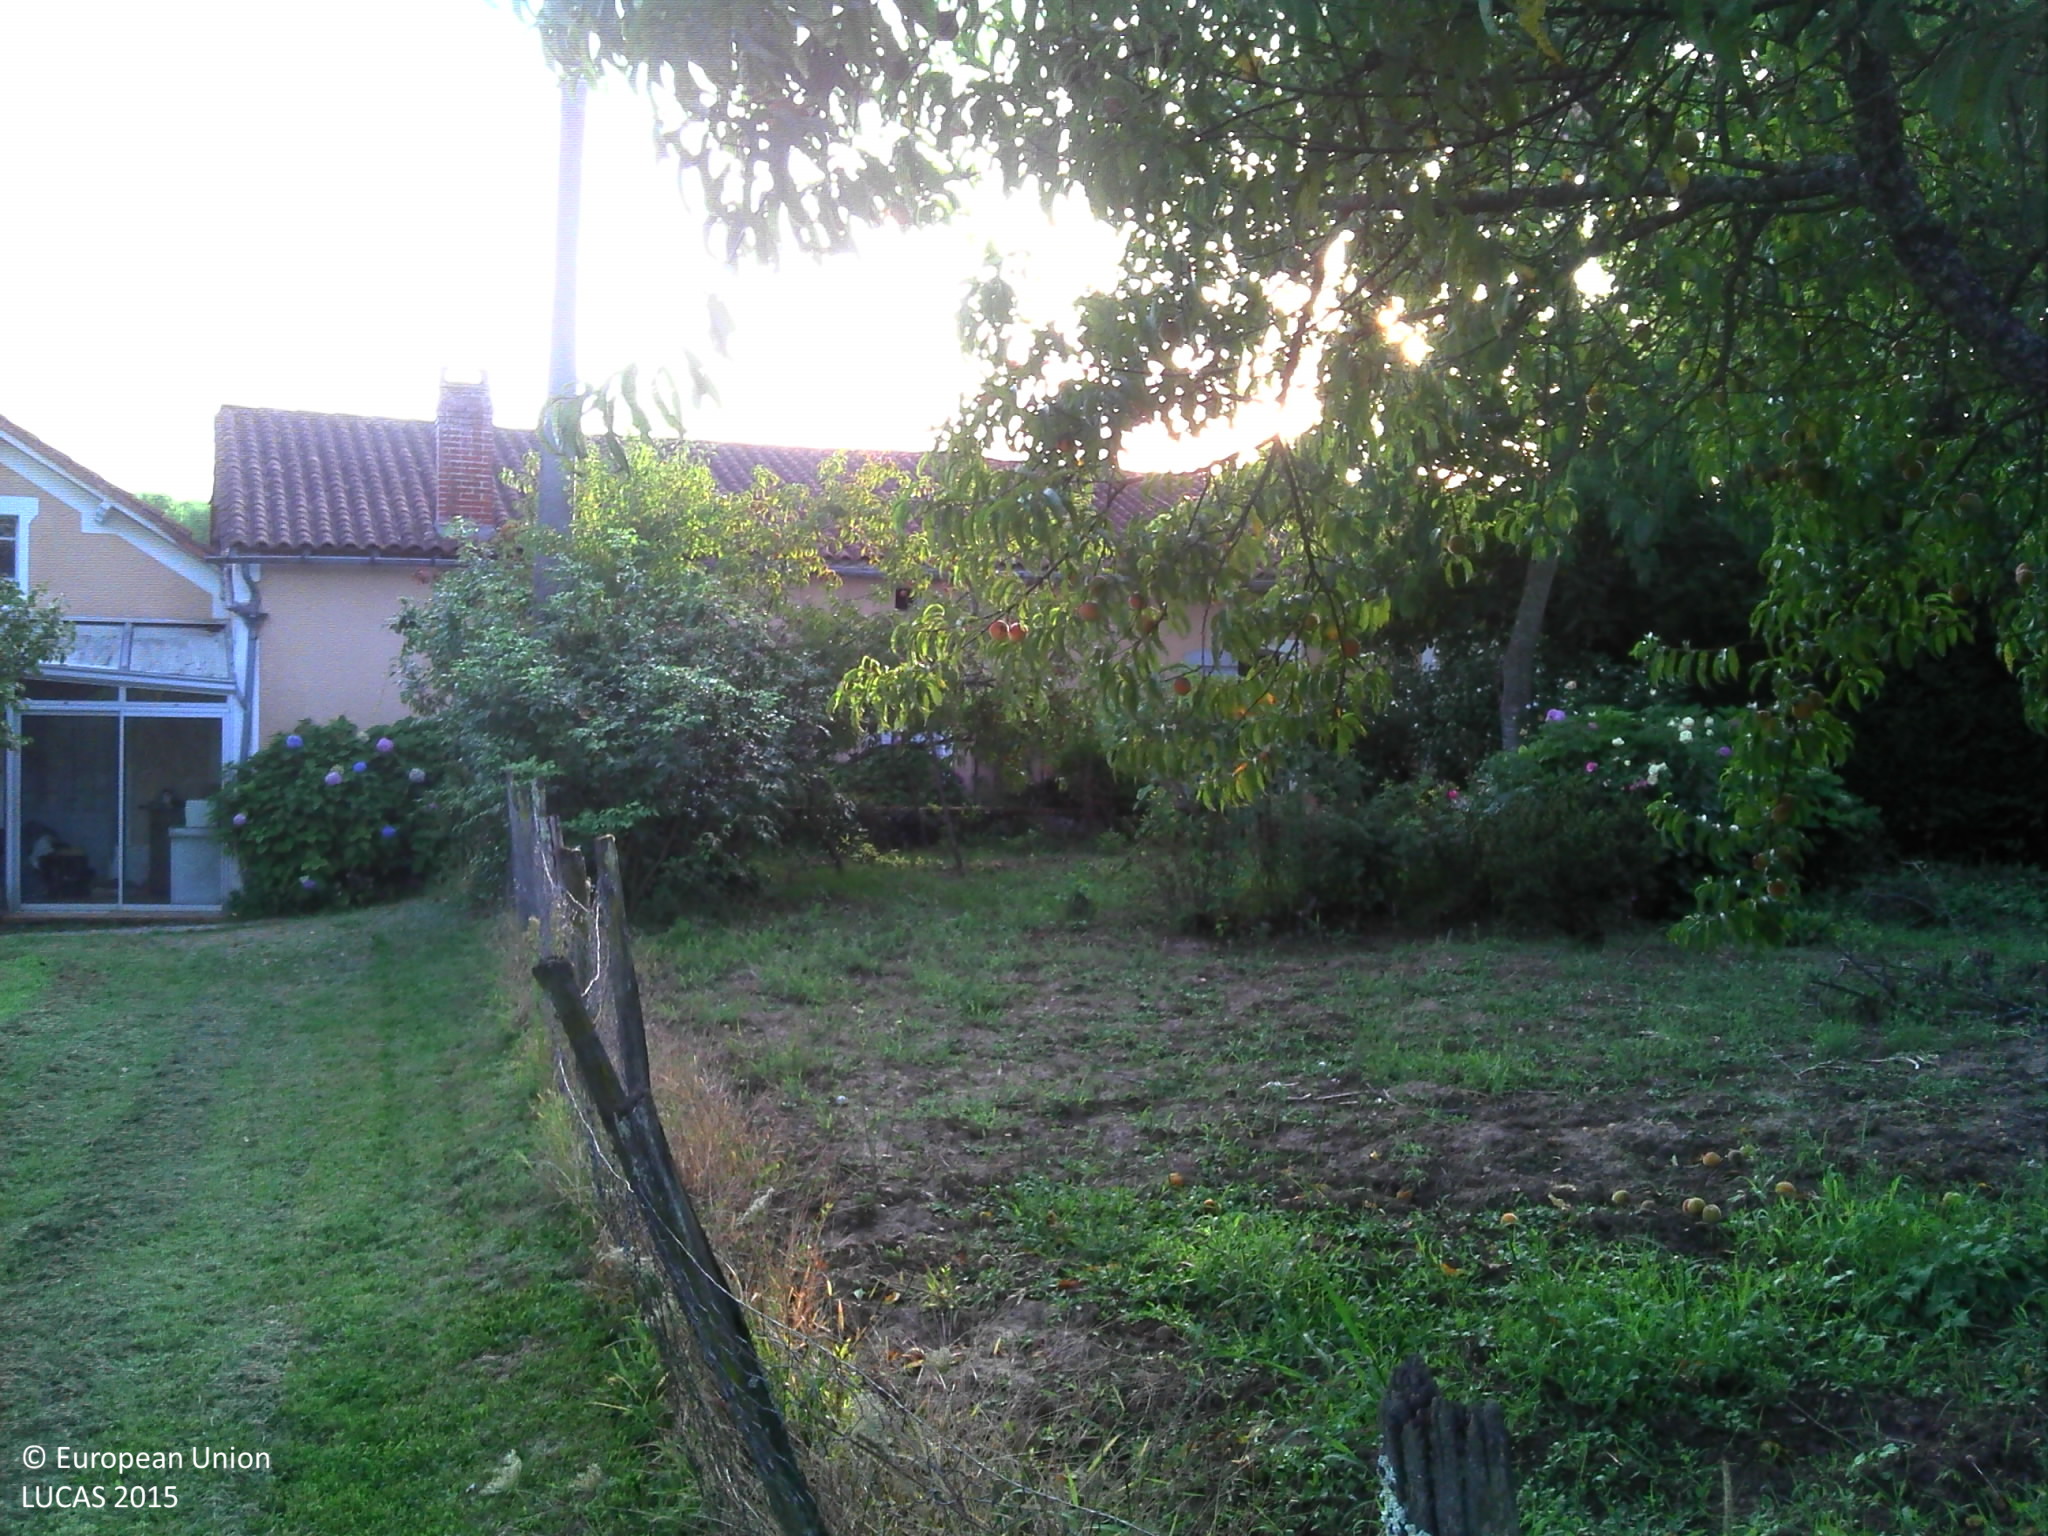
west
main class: Cropland
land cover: Other fruit trees and berries
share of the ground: 25 - 50 %
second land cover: Grassland without tree/shrub cover
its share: 50 - 75 %
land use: Kitchen garden
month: August
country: FR
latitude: 45.1311
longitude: 0.5164
